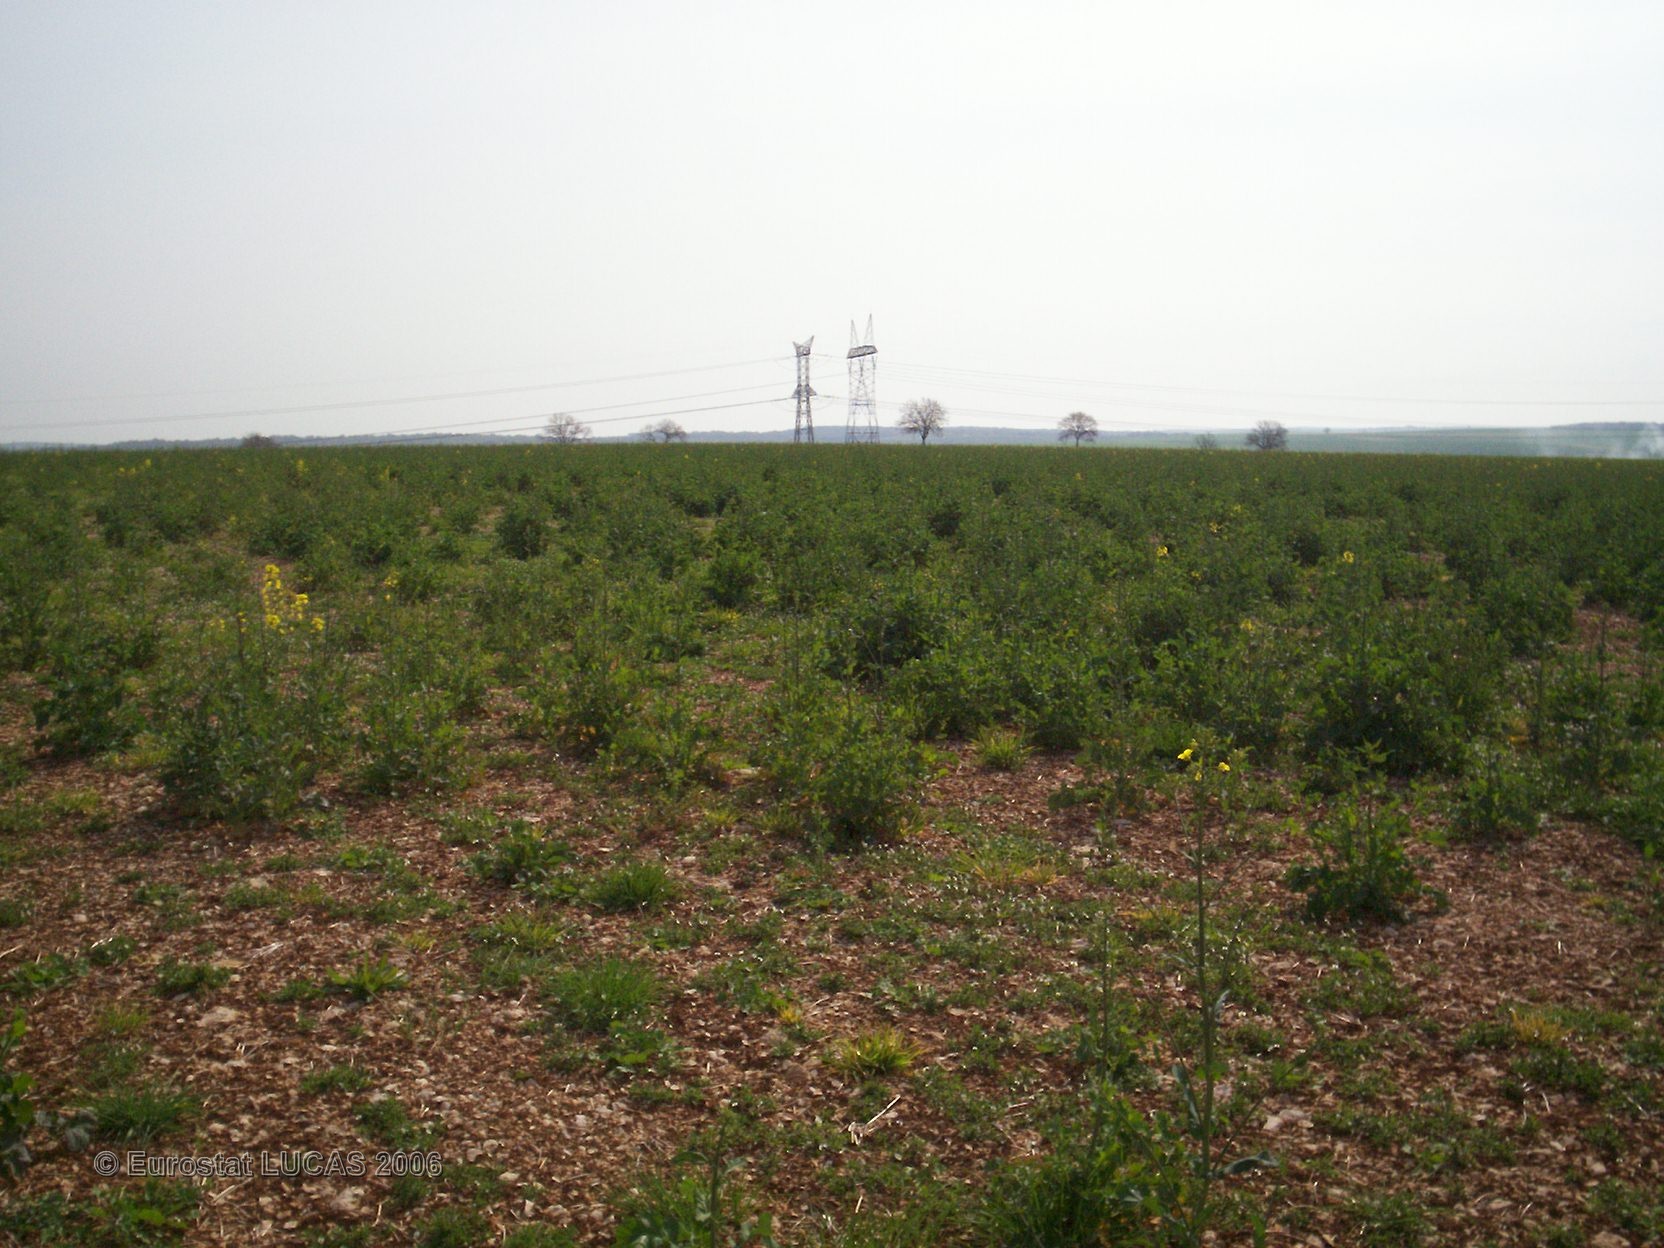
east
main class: Cropland
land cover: Rape and turnip rape
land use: Agriculture (excluding fallow land and kitchen gardens)
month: May
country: FR
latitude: 47.5843
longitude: 4.5608
